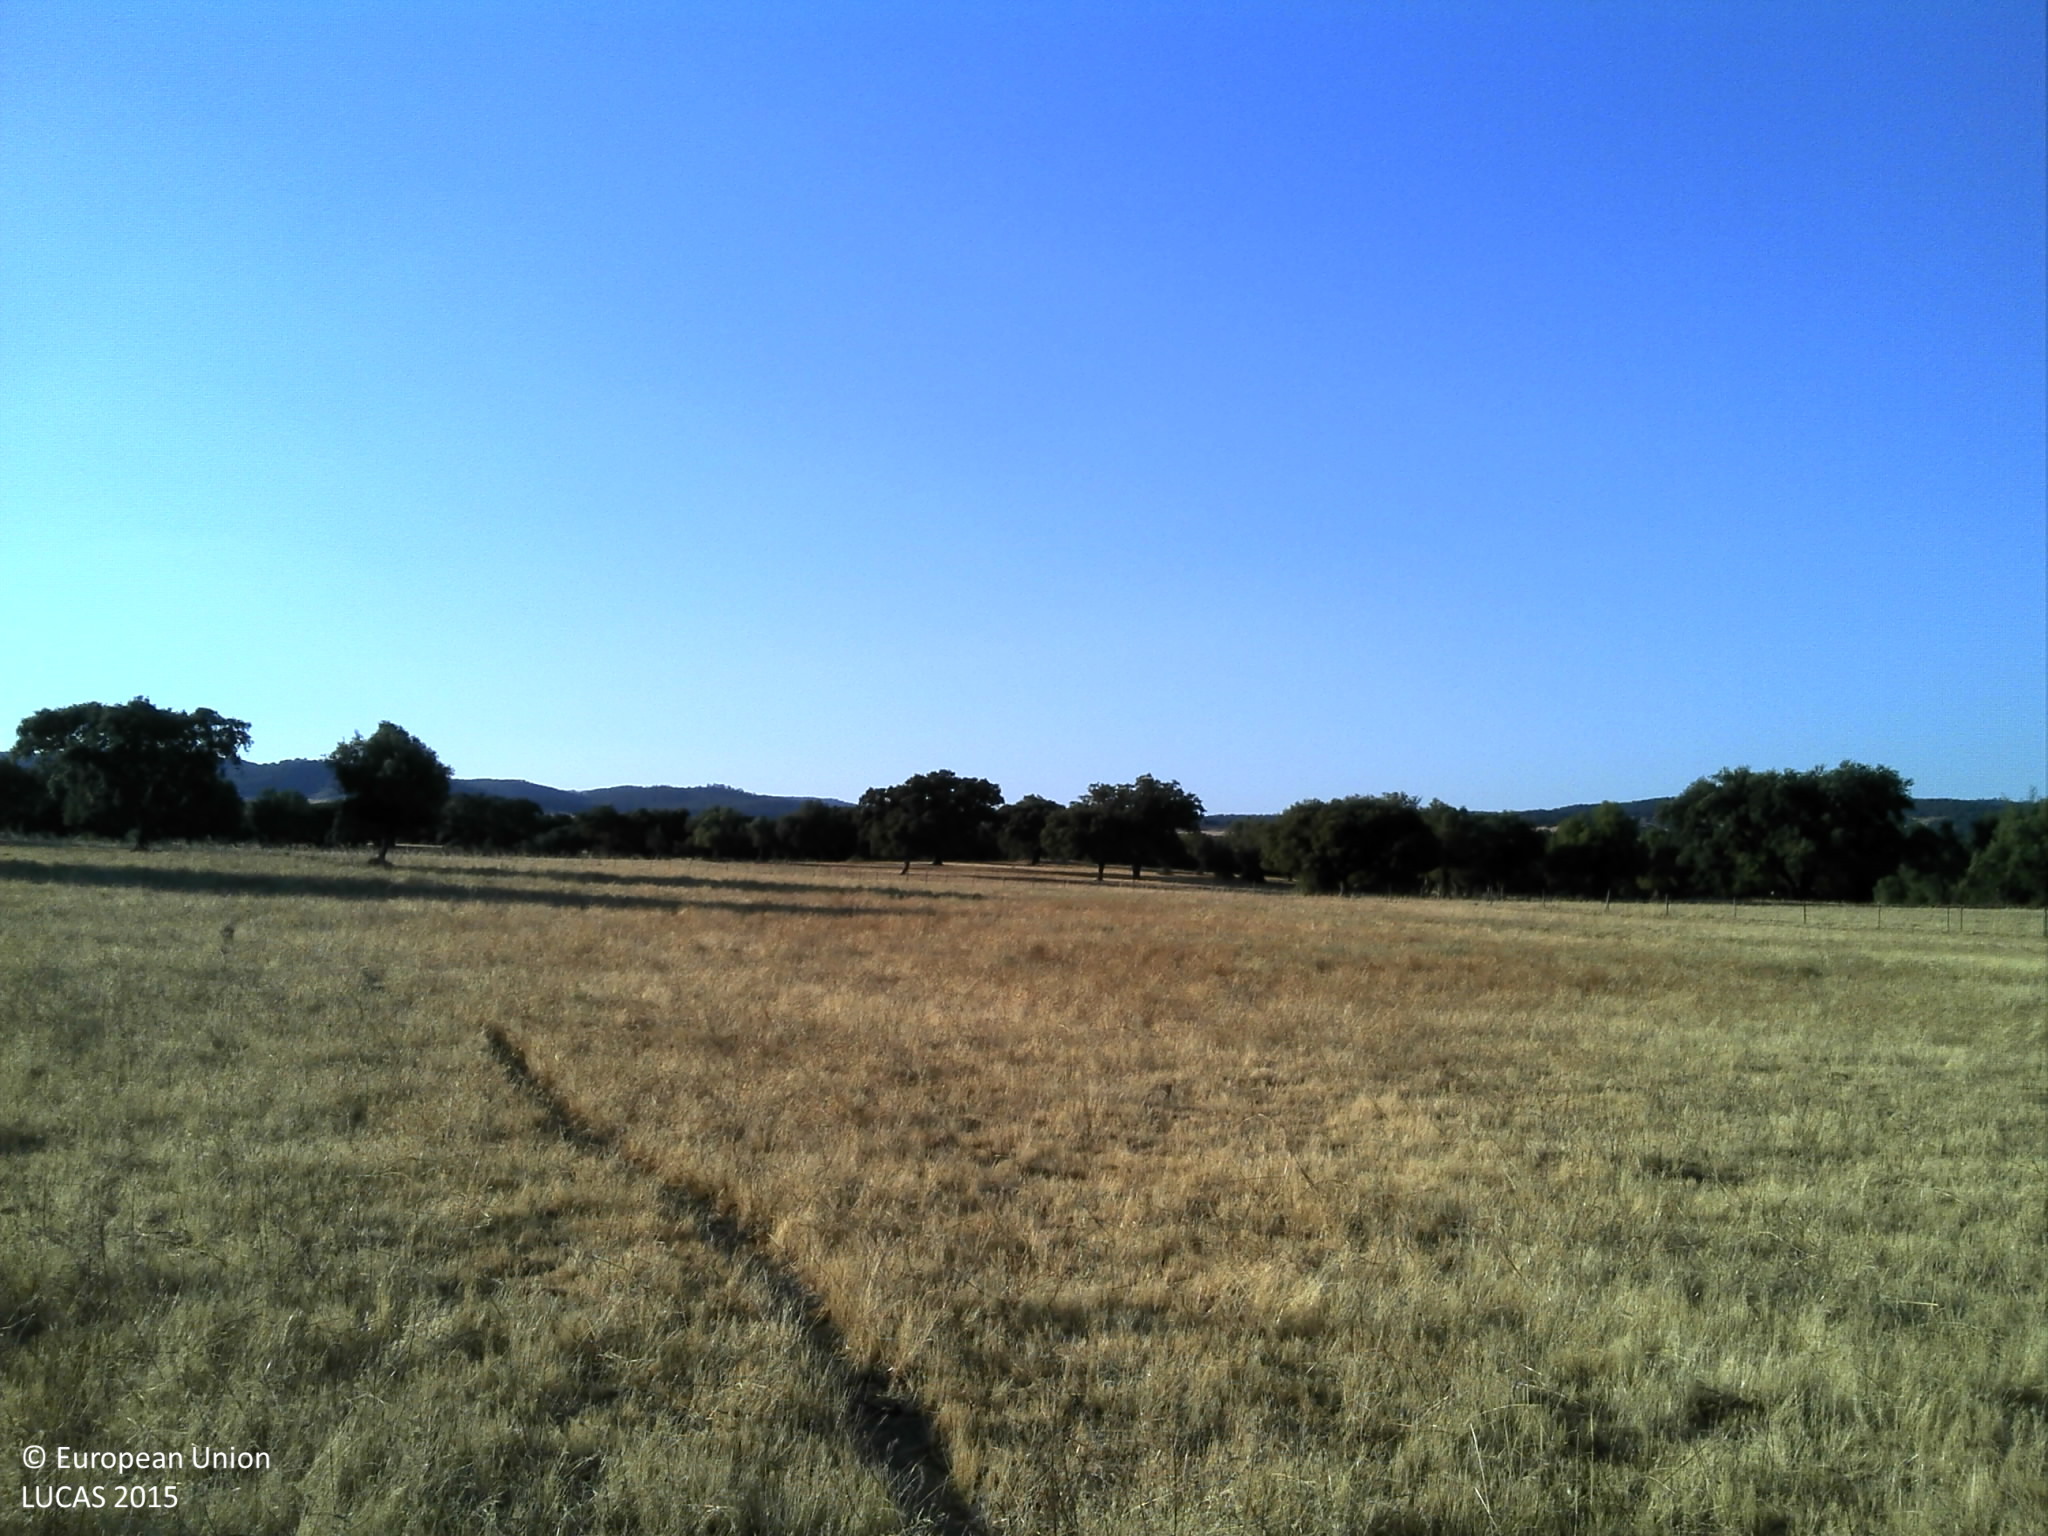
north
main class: Grassland
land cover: Spontaneously vegetated surfaces
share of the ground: 10 - 25 %
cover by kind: unconsolidated bare surface 75 %, herbaceous plants 25 %
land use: Agriculture (excluding fallow land and kitchen gardens)
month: June
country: PT
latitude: 38.4938
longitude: -8.1007
